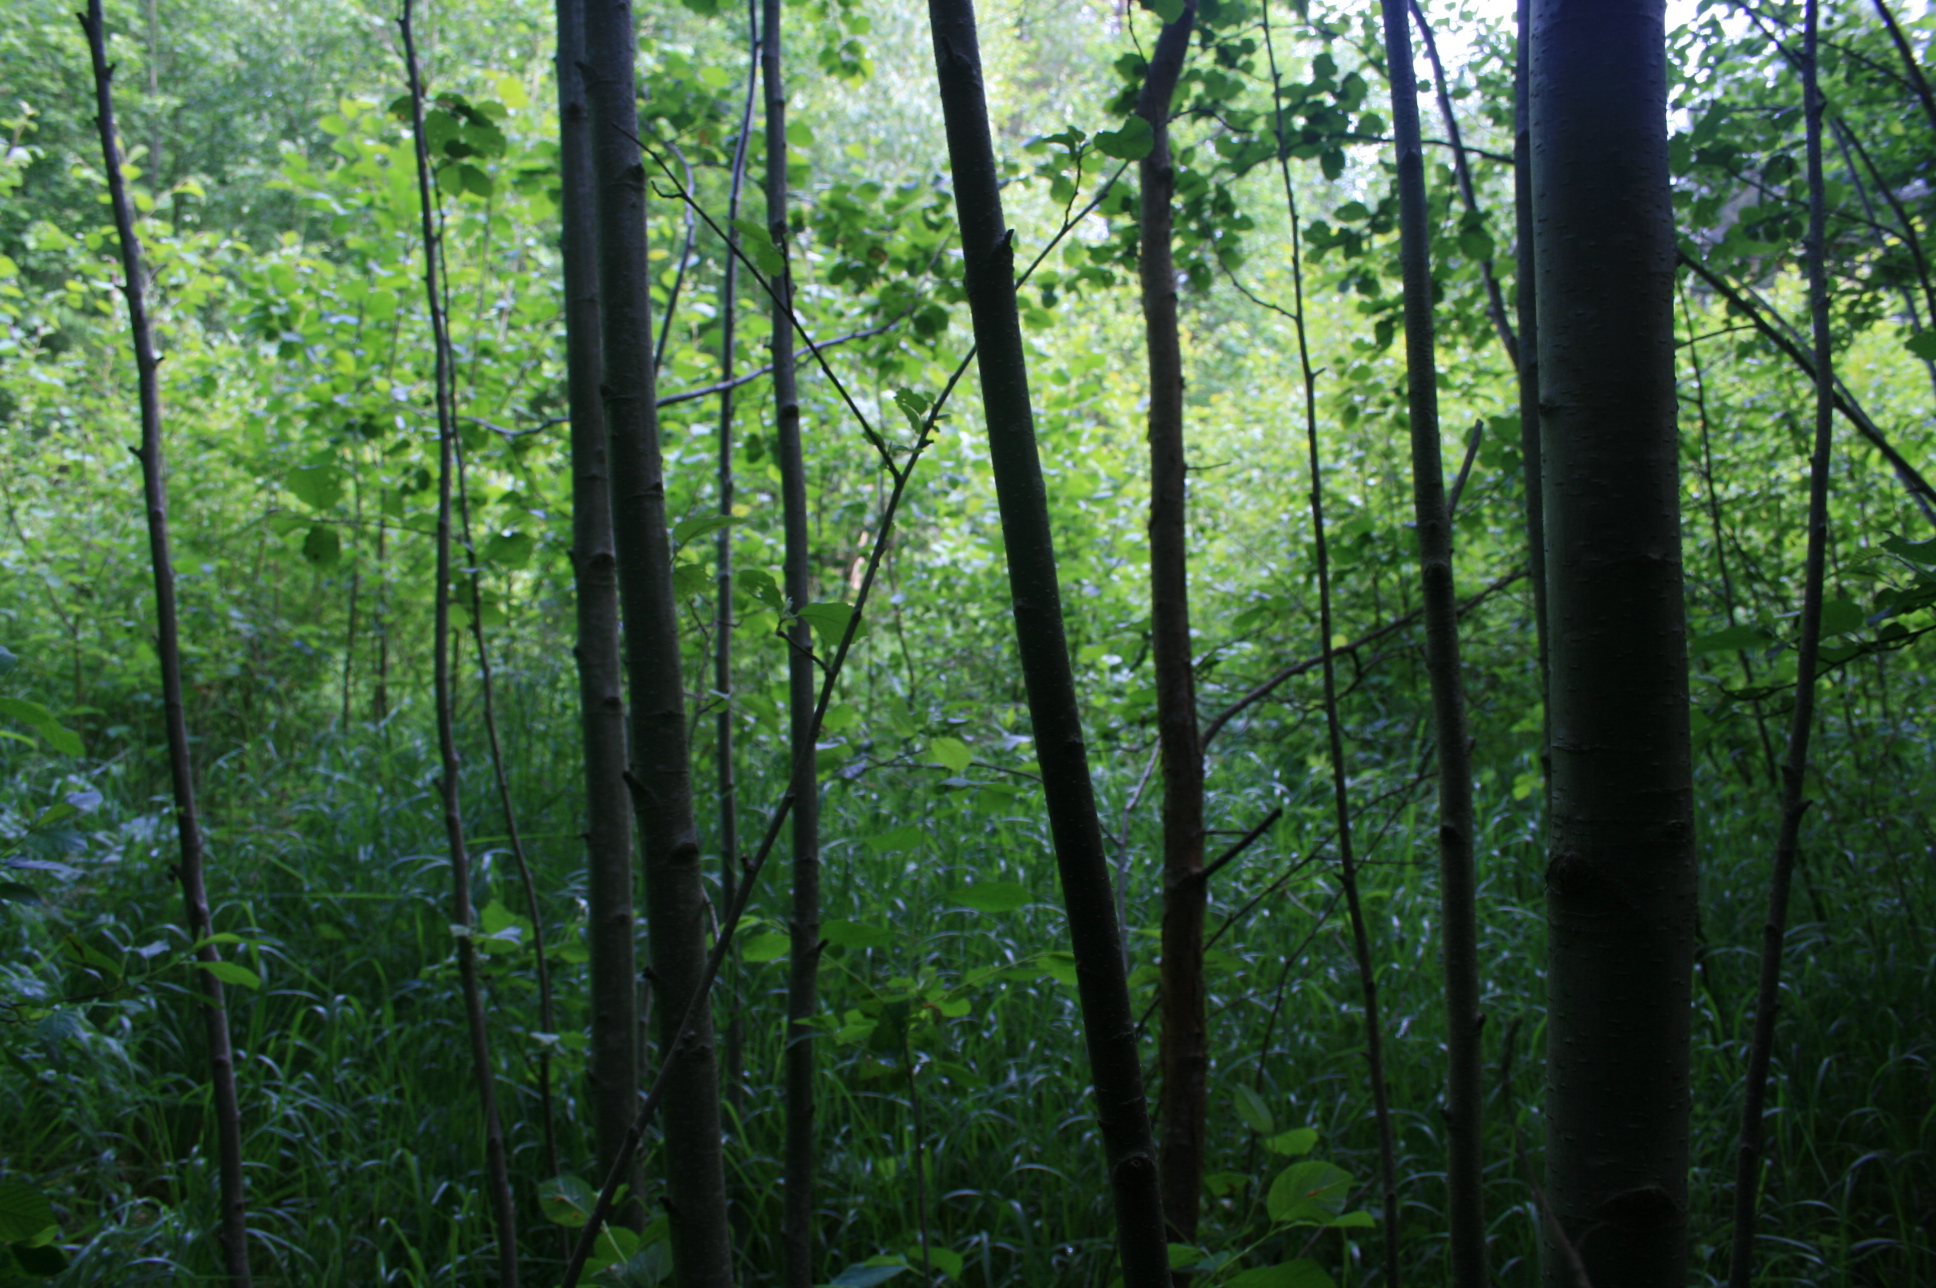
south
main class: Woodland
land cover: Spruce dominated mixed woodland
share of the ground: > 75 %
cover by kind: broadleaved forest trees 70 %, coniferous forest trees 30 %
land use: Forestry
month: June
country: LT
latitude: 55.4794
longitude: 22.1598
